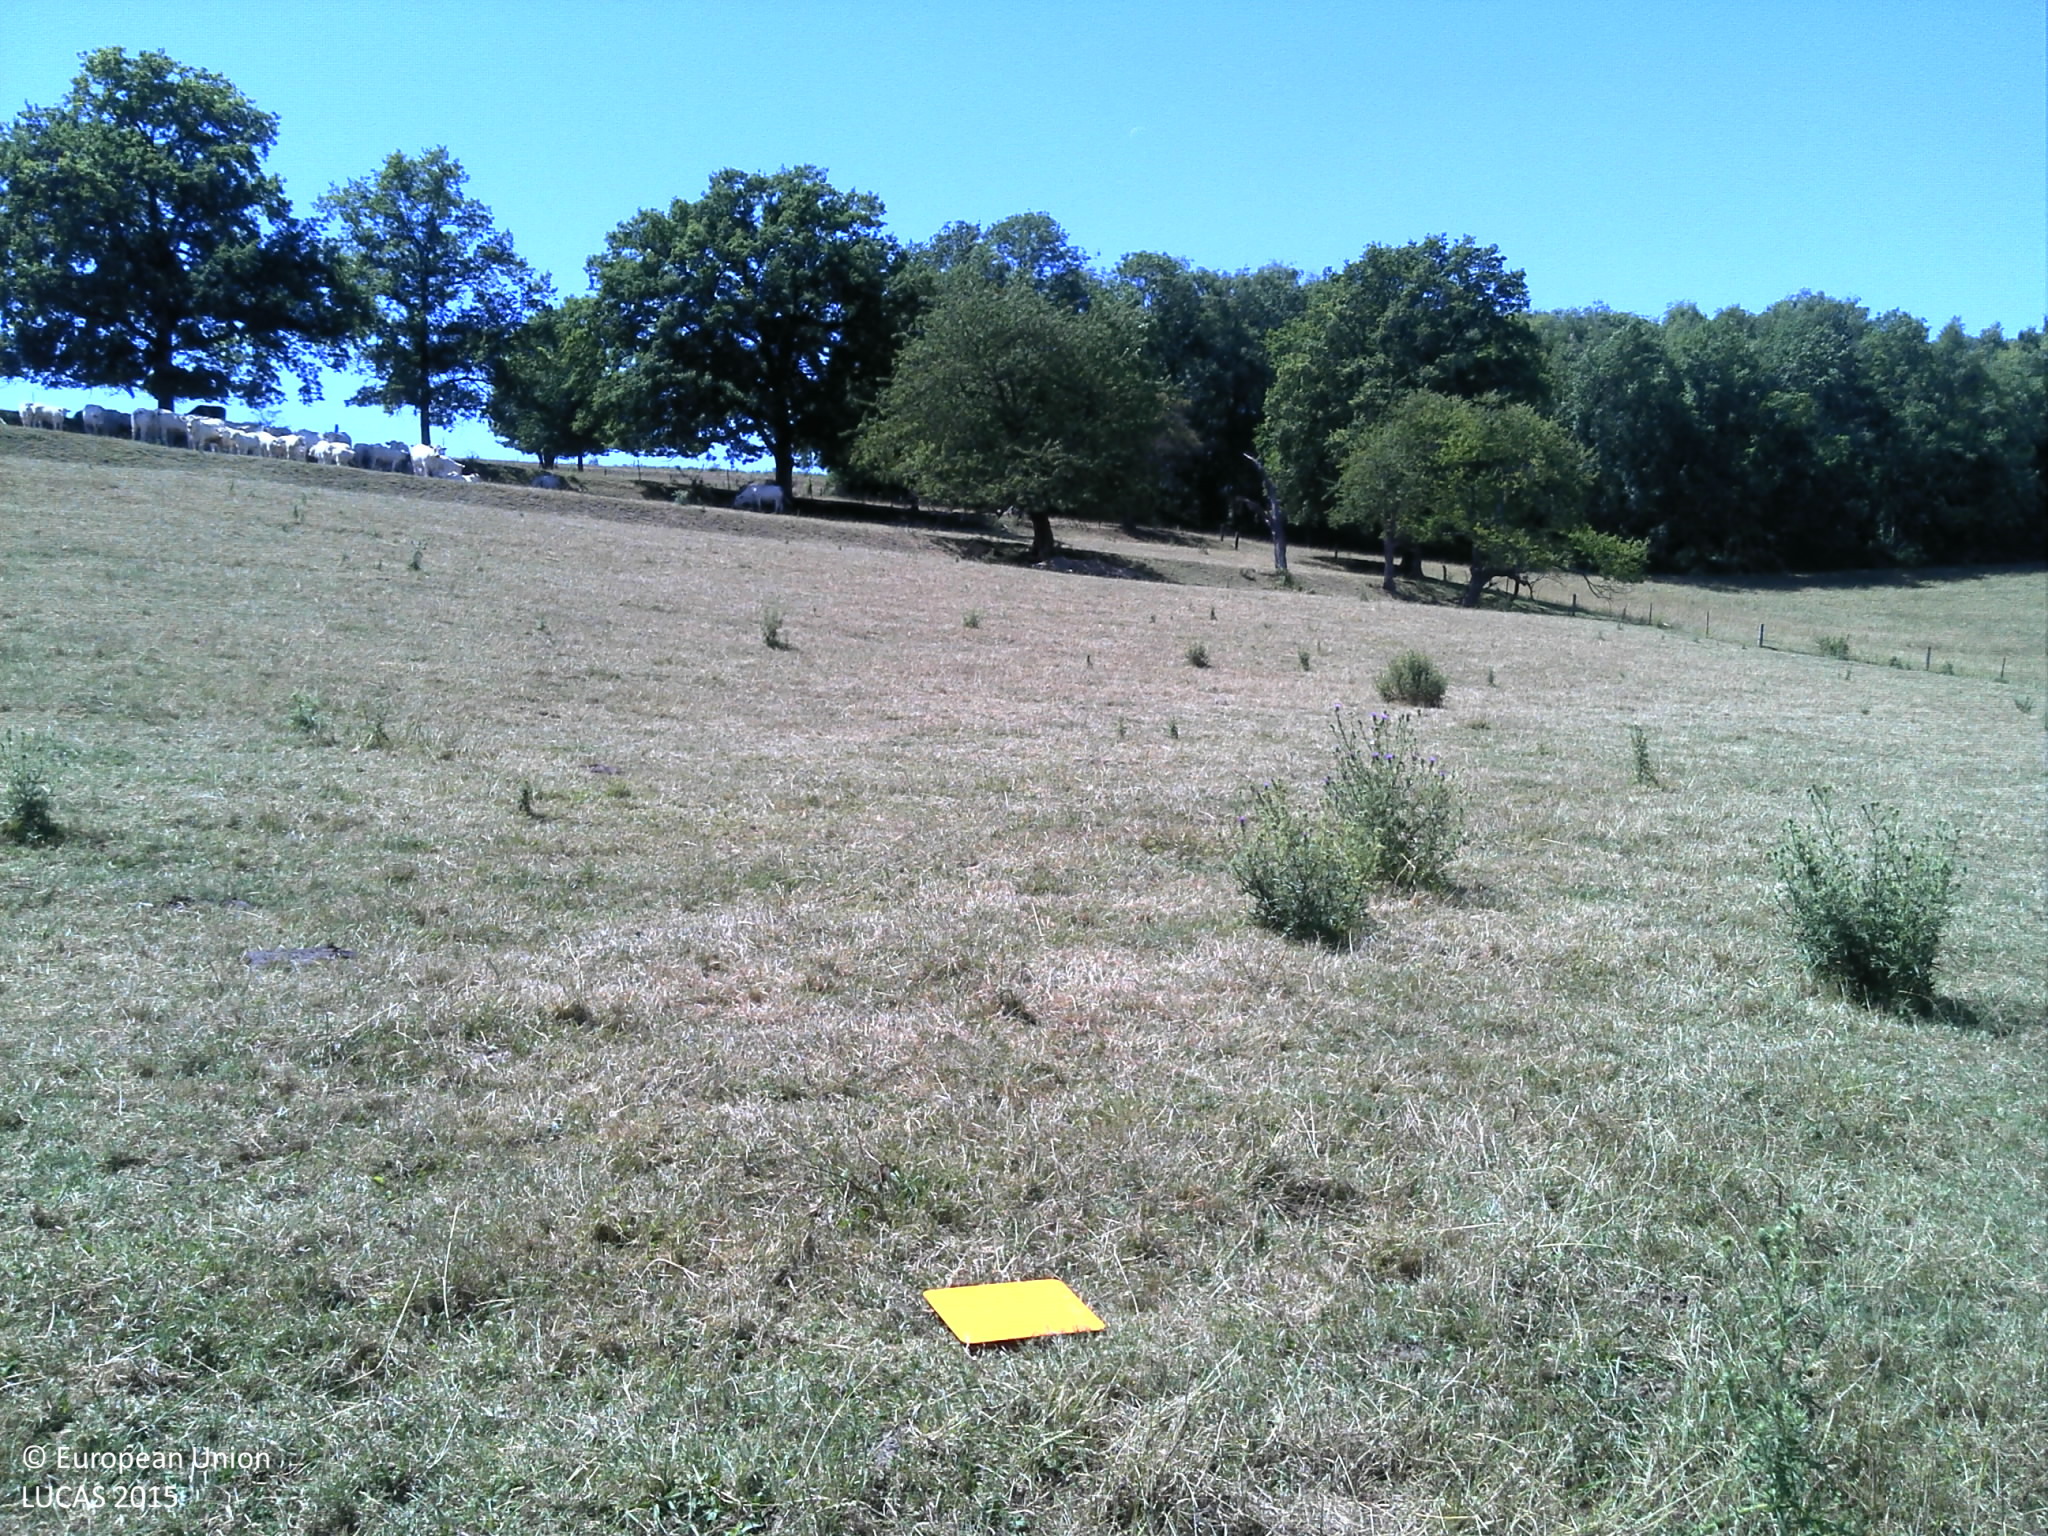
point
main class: Grassland
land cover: Grassland with sparse tree/shrub cover
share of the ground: > 75 %
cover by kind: herbaceous plants 95 %, broadleaved forest trees 5 %
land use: Agriculture (excluding fallow land and kitchen gardens)
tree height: > 5 m
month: July
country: FR
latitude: 49.5578
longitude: 4.7298
